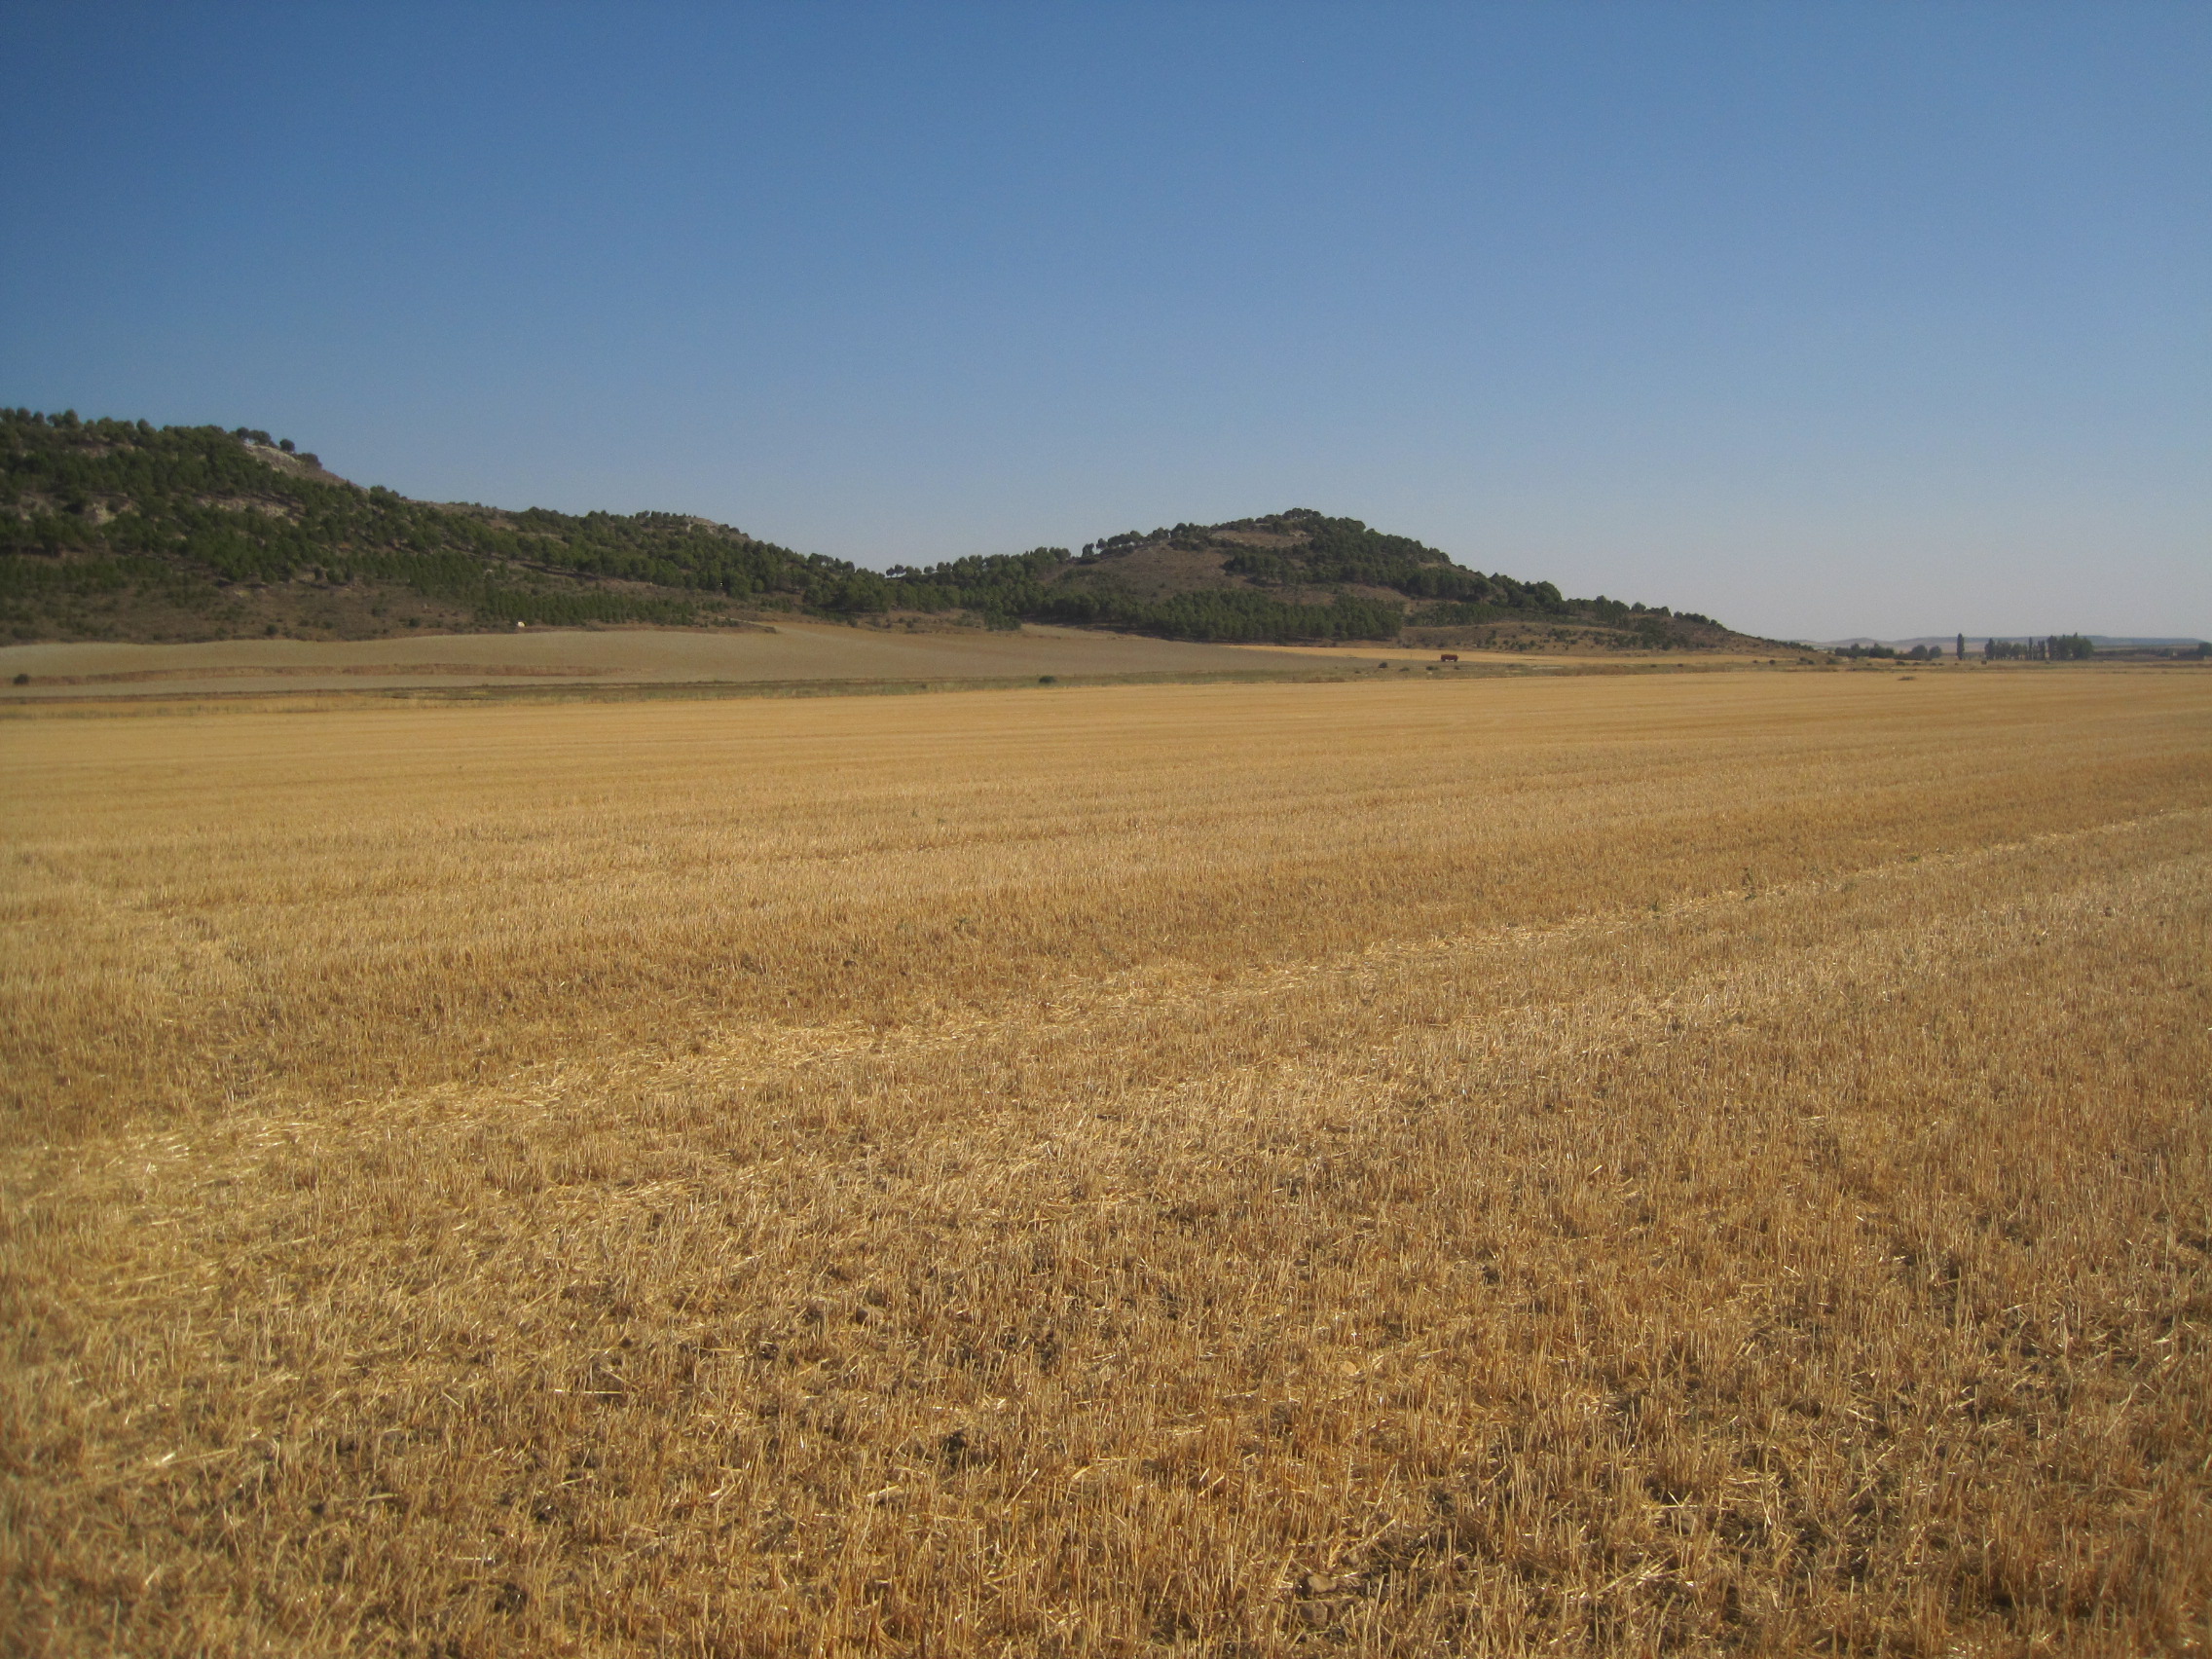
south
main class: Cropland
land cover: Barley
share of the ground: < 10 %
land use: Agriculture (excluding fallow land and kitchen gardens)
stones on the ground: 10 - 25 %
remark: Harvested field
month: July
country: ES
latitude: 41.6681
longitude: -5.1748
